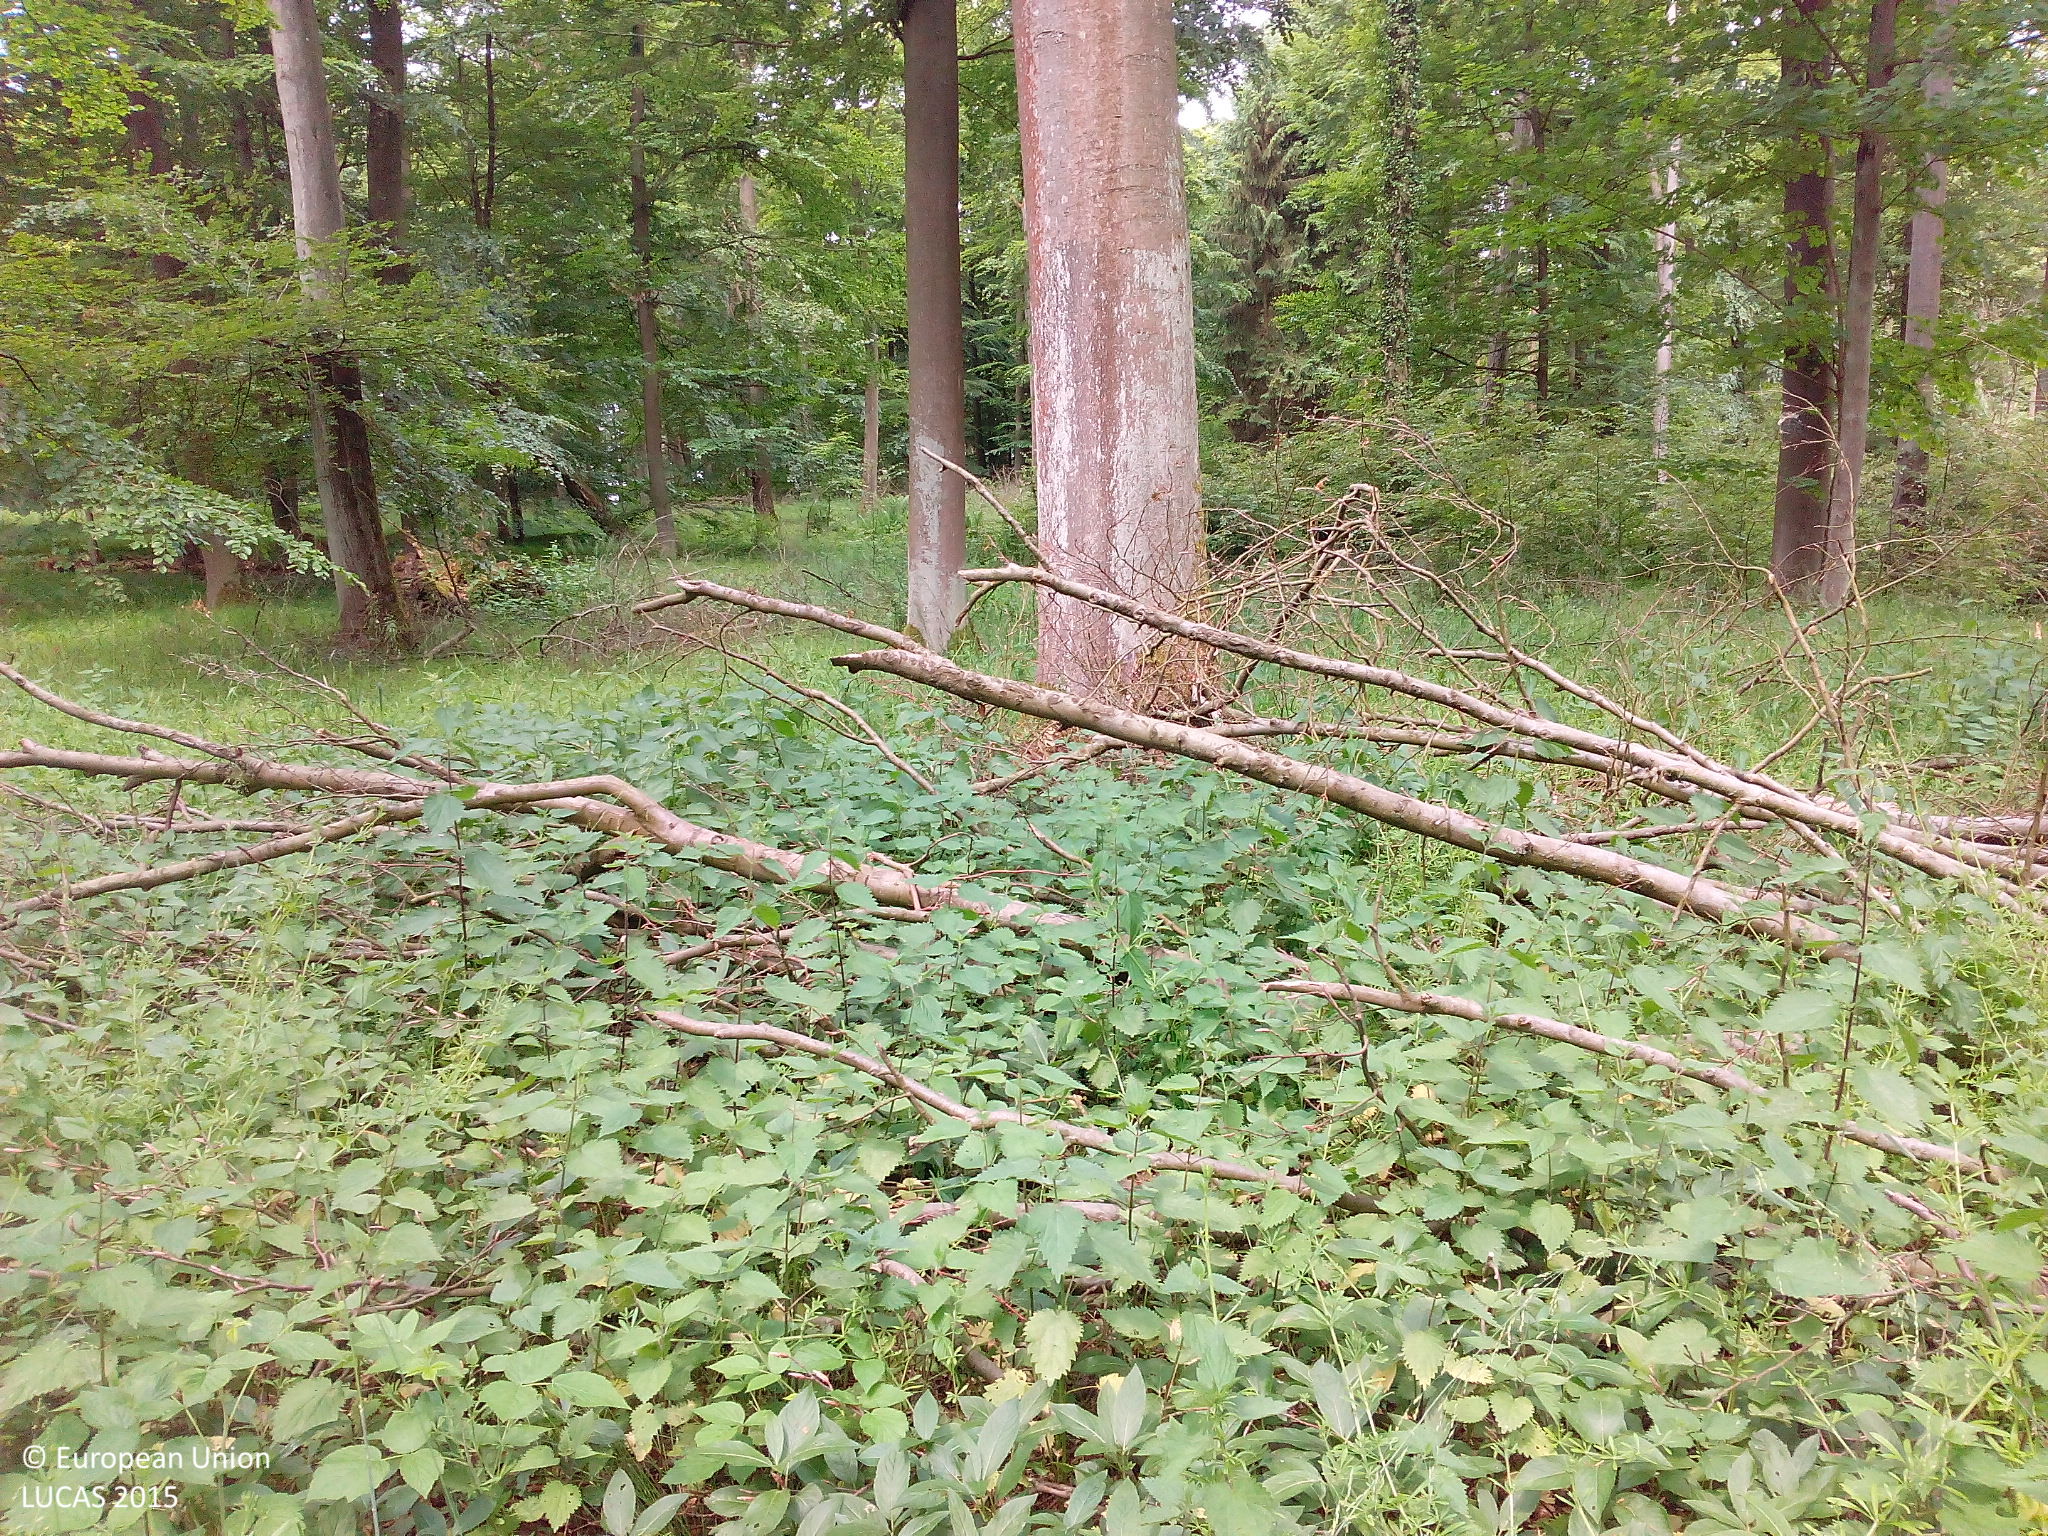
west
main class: Woodland
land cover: Broadleaved woodland
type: beech forest
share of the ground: > 75 %
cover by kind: broadleaved forest trees 75 %, herbaceous plants 20 %, unconsolidated bare surface 5 %
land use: Forestry
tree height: > 5 m
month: June
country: DE
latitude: 51.2066
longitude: 9.2416
